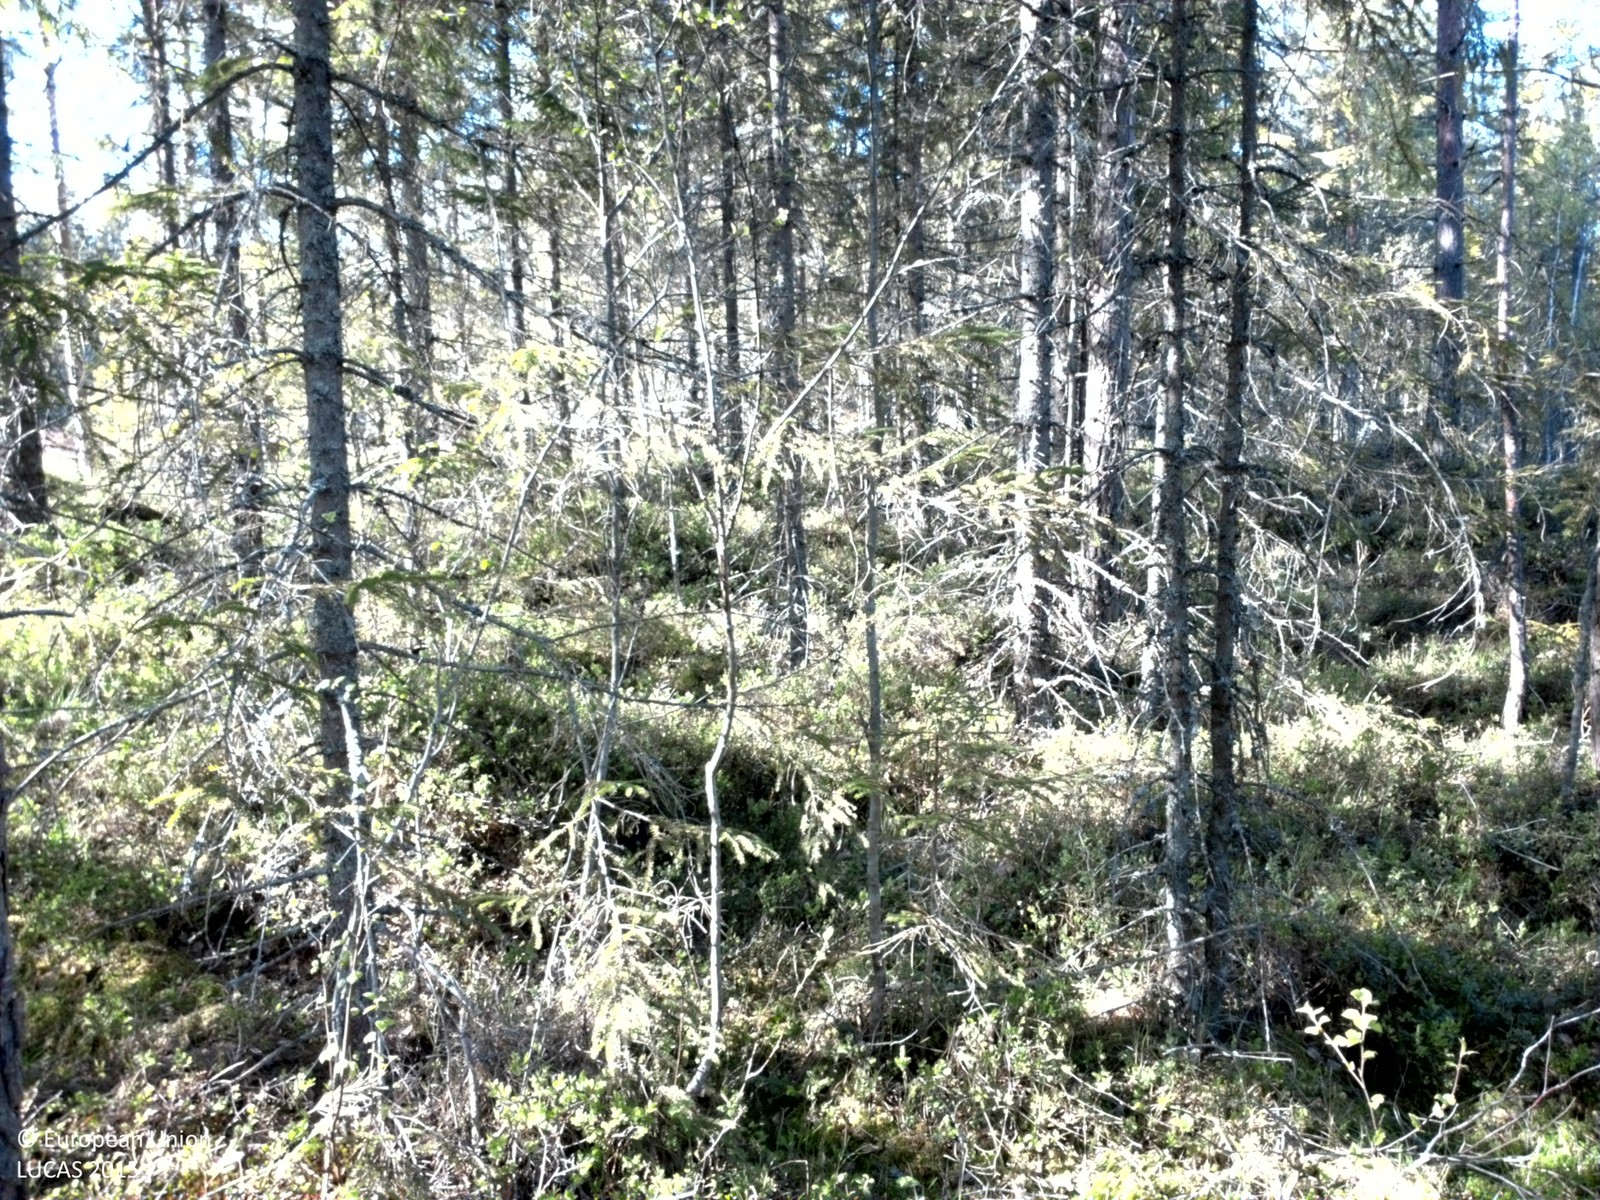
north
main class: Woodland
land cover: Spruce dominated coniferous woodland
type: boreal forest
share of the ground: > 75 %
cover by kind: coniferous forest trees 80 %, lichens and mosses 10 %, broadleaved forest trees 5 %, shrubs 5 %
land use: Forestry
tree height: > 5 m
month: May
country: SE
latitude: 59.4943
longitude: 12.3782
